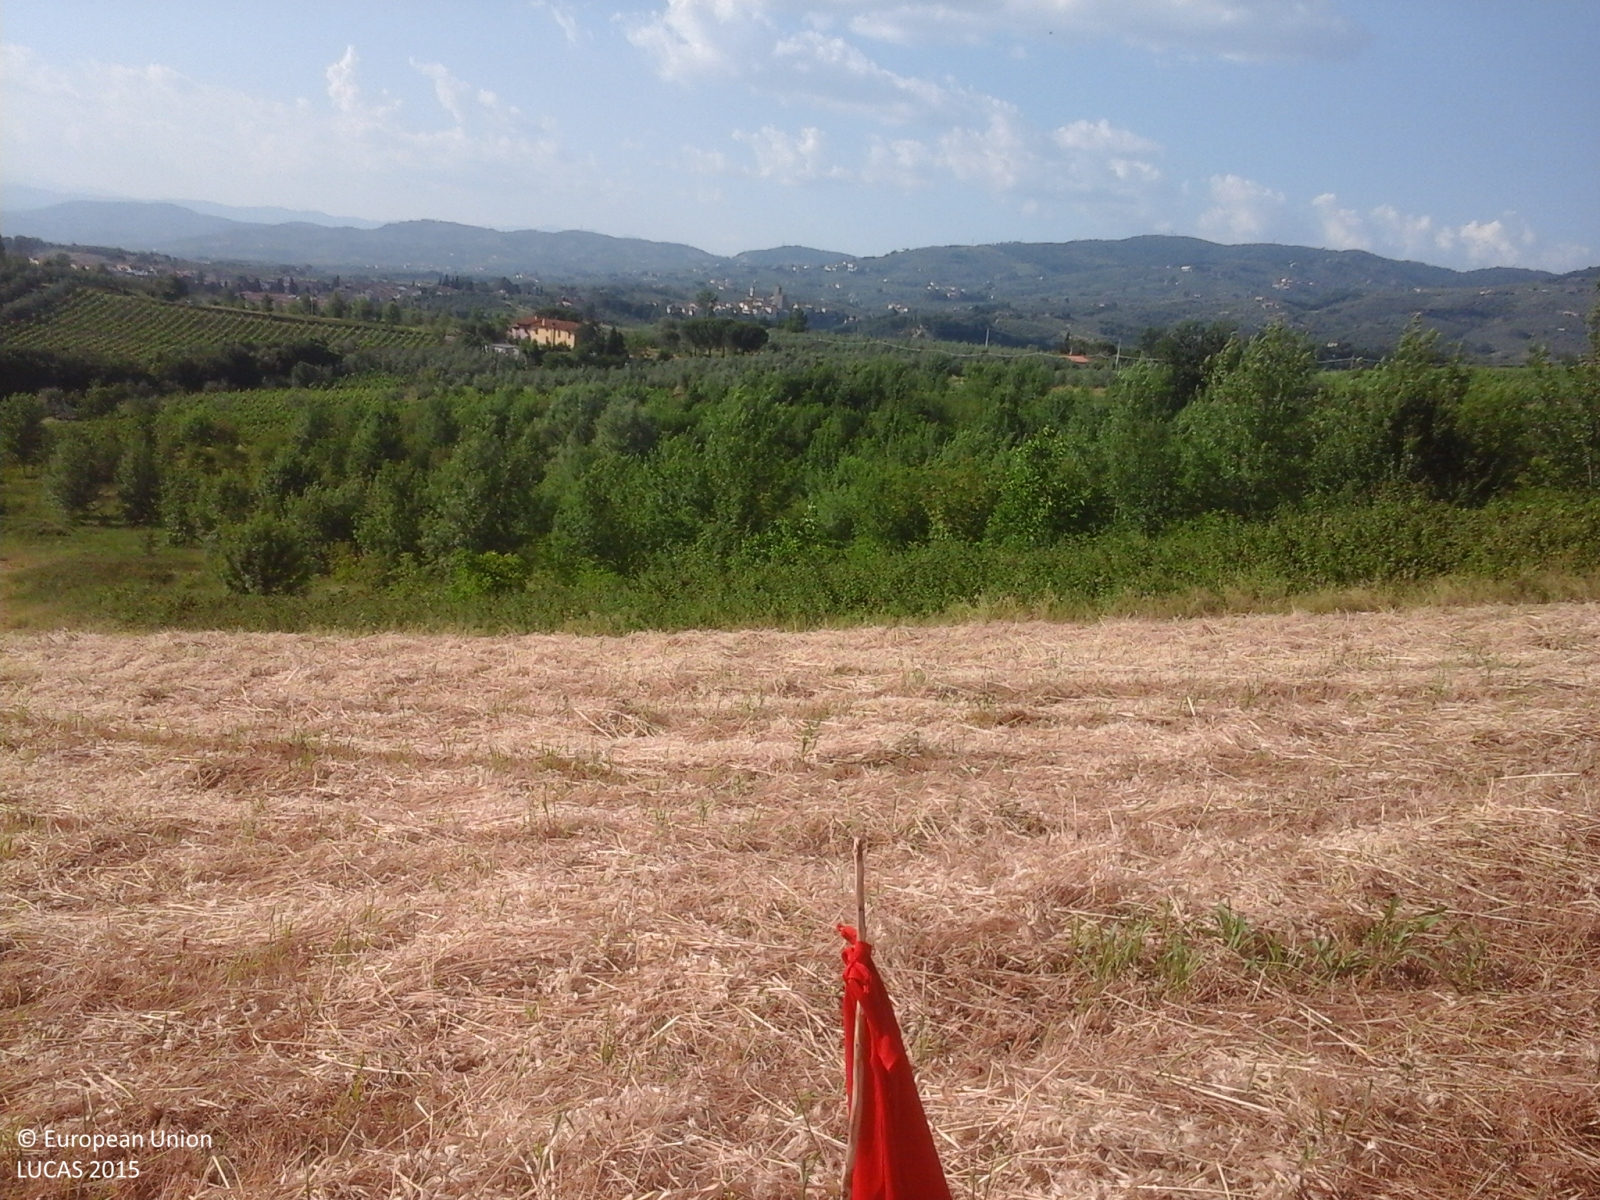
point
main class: Cropland
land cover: Mixed cereals for fodder
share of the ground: > 75 %
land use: Agriculture (excluding fallow land and kitchen gardens)
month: June
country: IT
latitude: 43.7691
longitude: 10.9293
